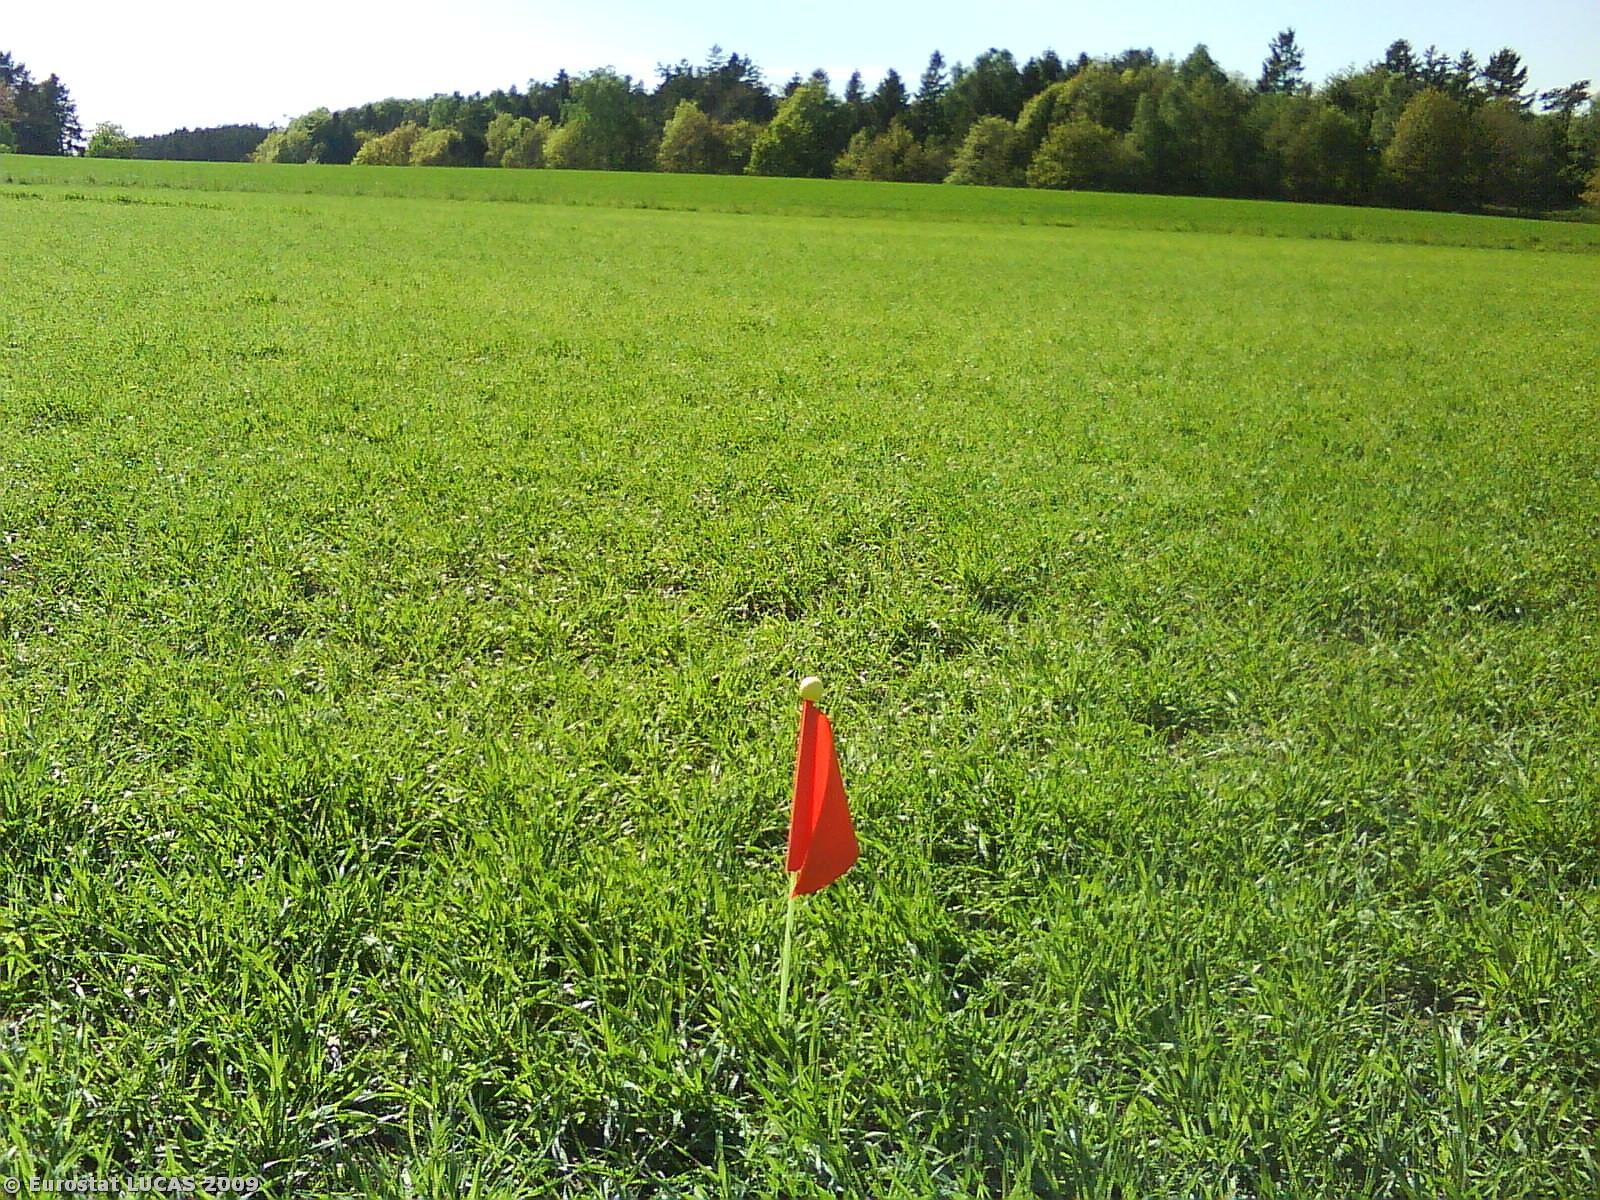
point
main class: Cropland
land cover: Barley
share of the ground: > 75 %
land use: Agriculture (excluding fallow land and kitchen gardens)
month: May
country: DK
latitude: 56.4373
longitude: 10.7289
